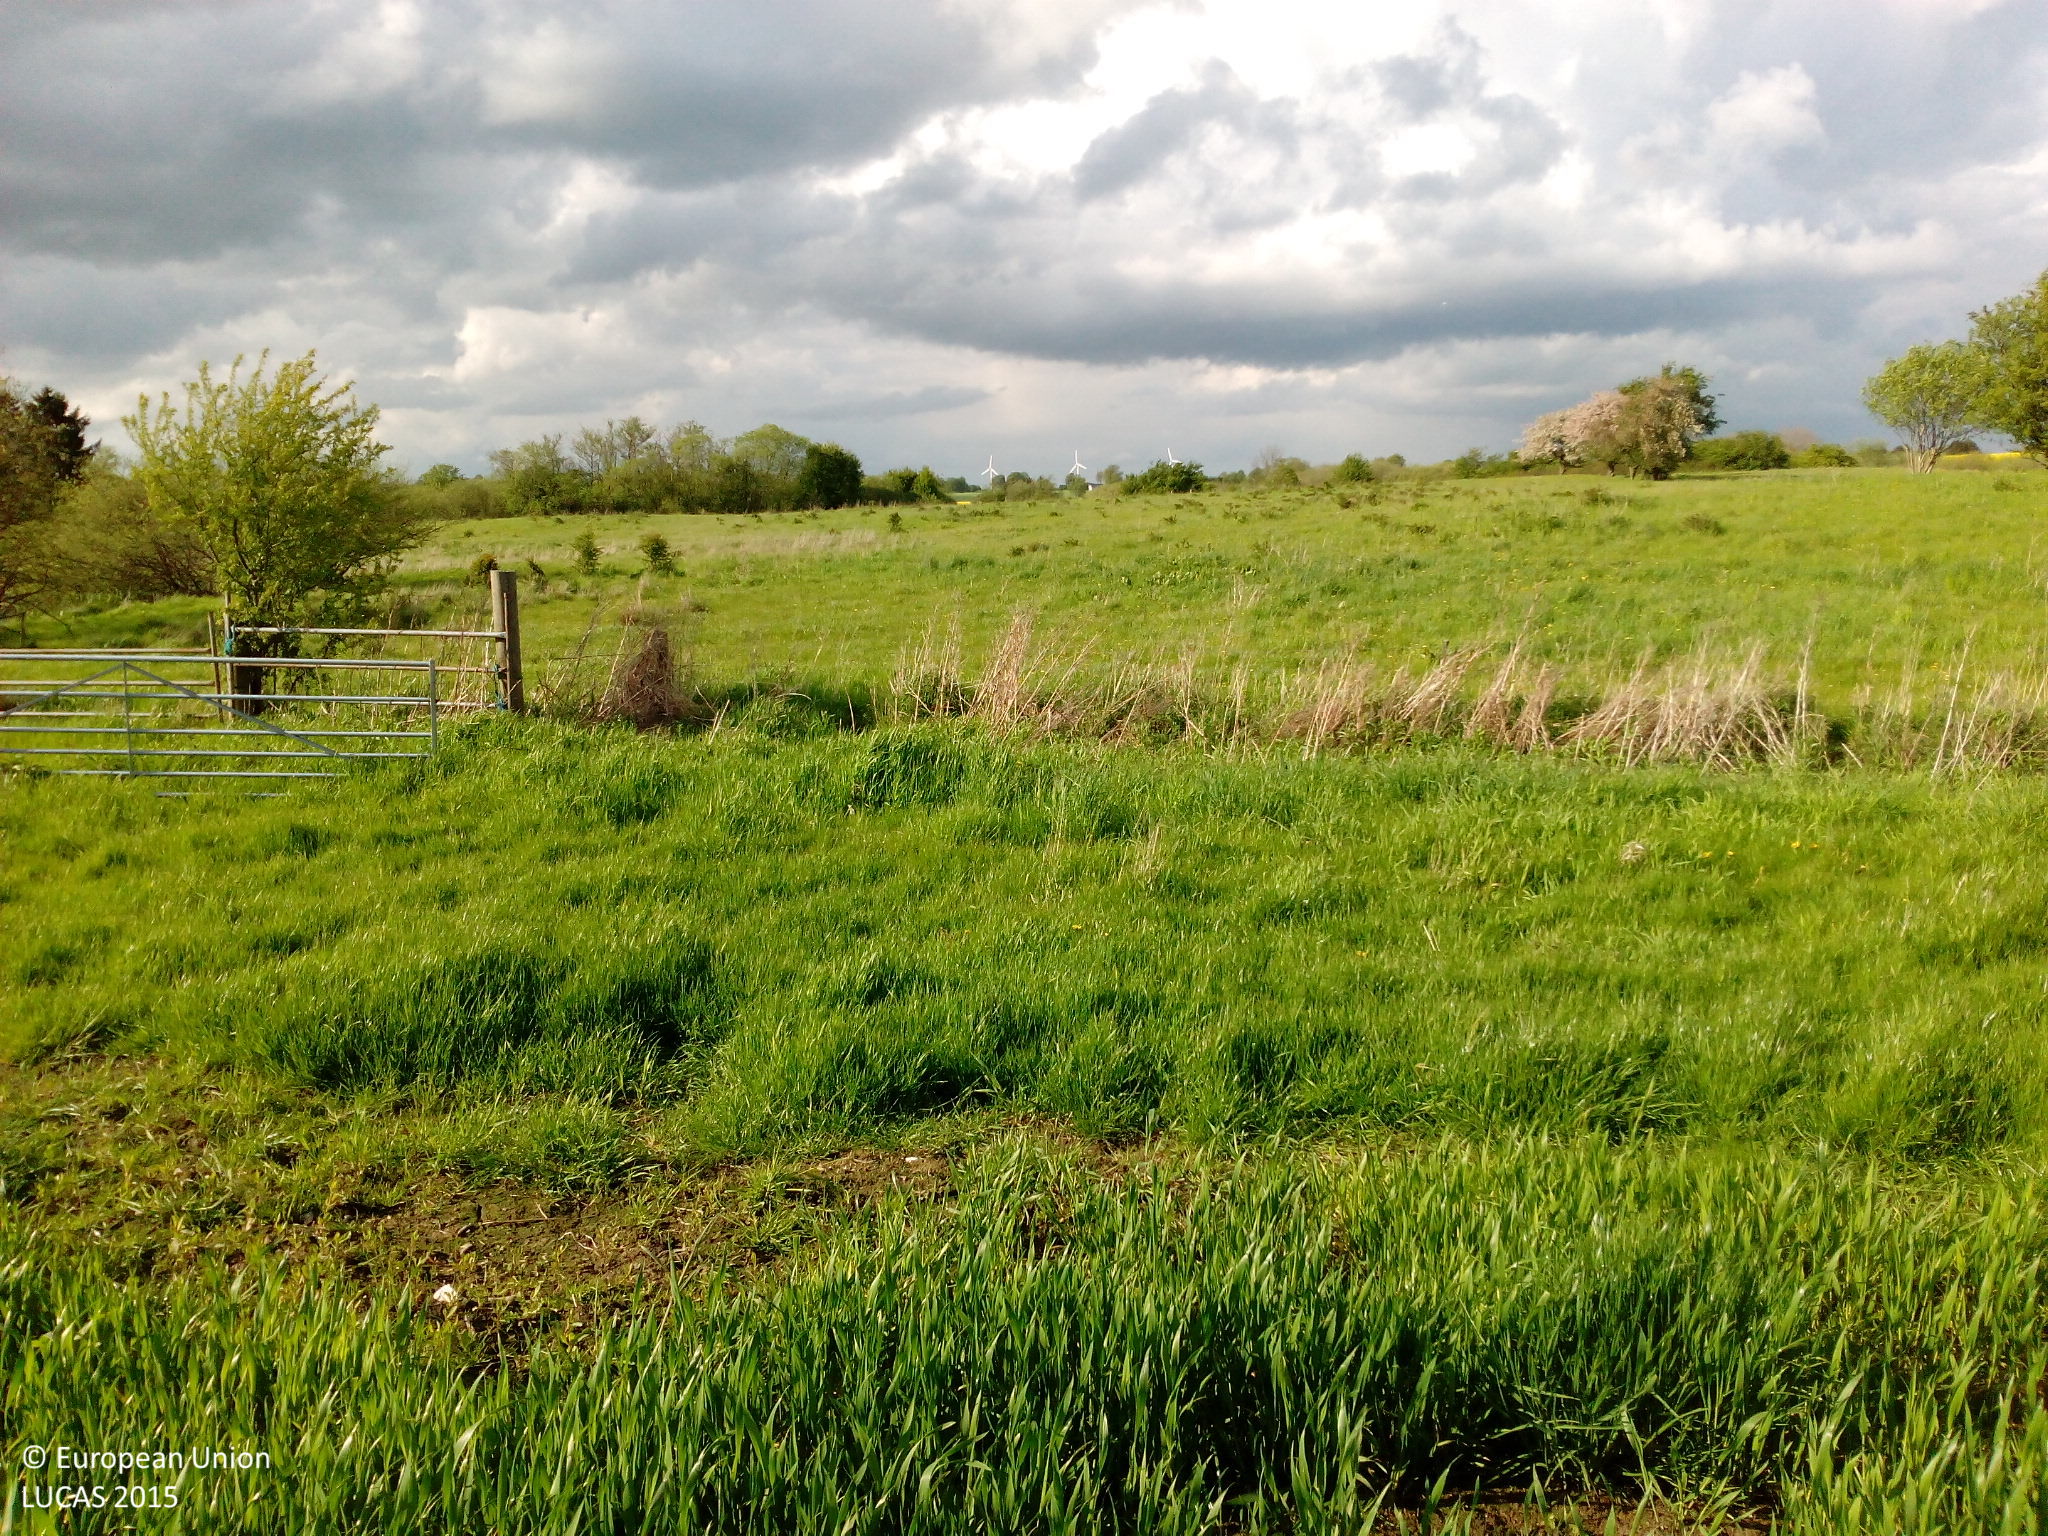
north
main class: Cropland
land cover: Common wheat
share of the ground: > 75 %
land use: Agriculture (excluding fallow land and kitchen gardens)
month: May
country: DK
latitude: 55.5781
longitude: 12.0445
